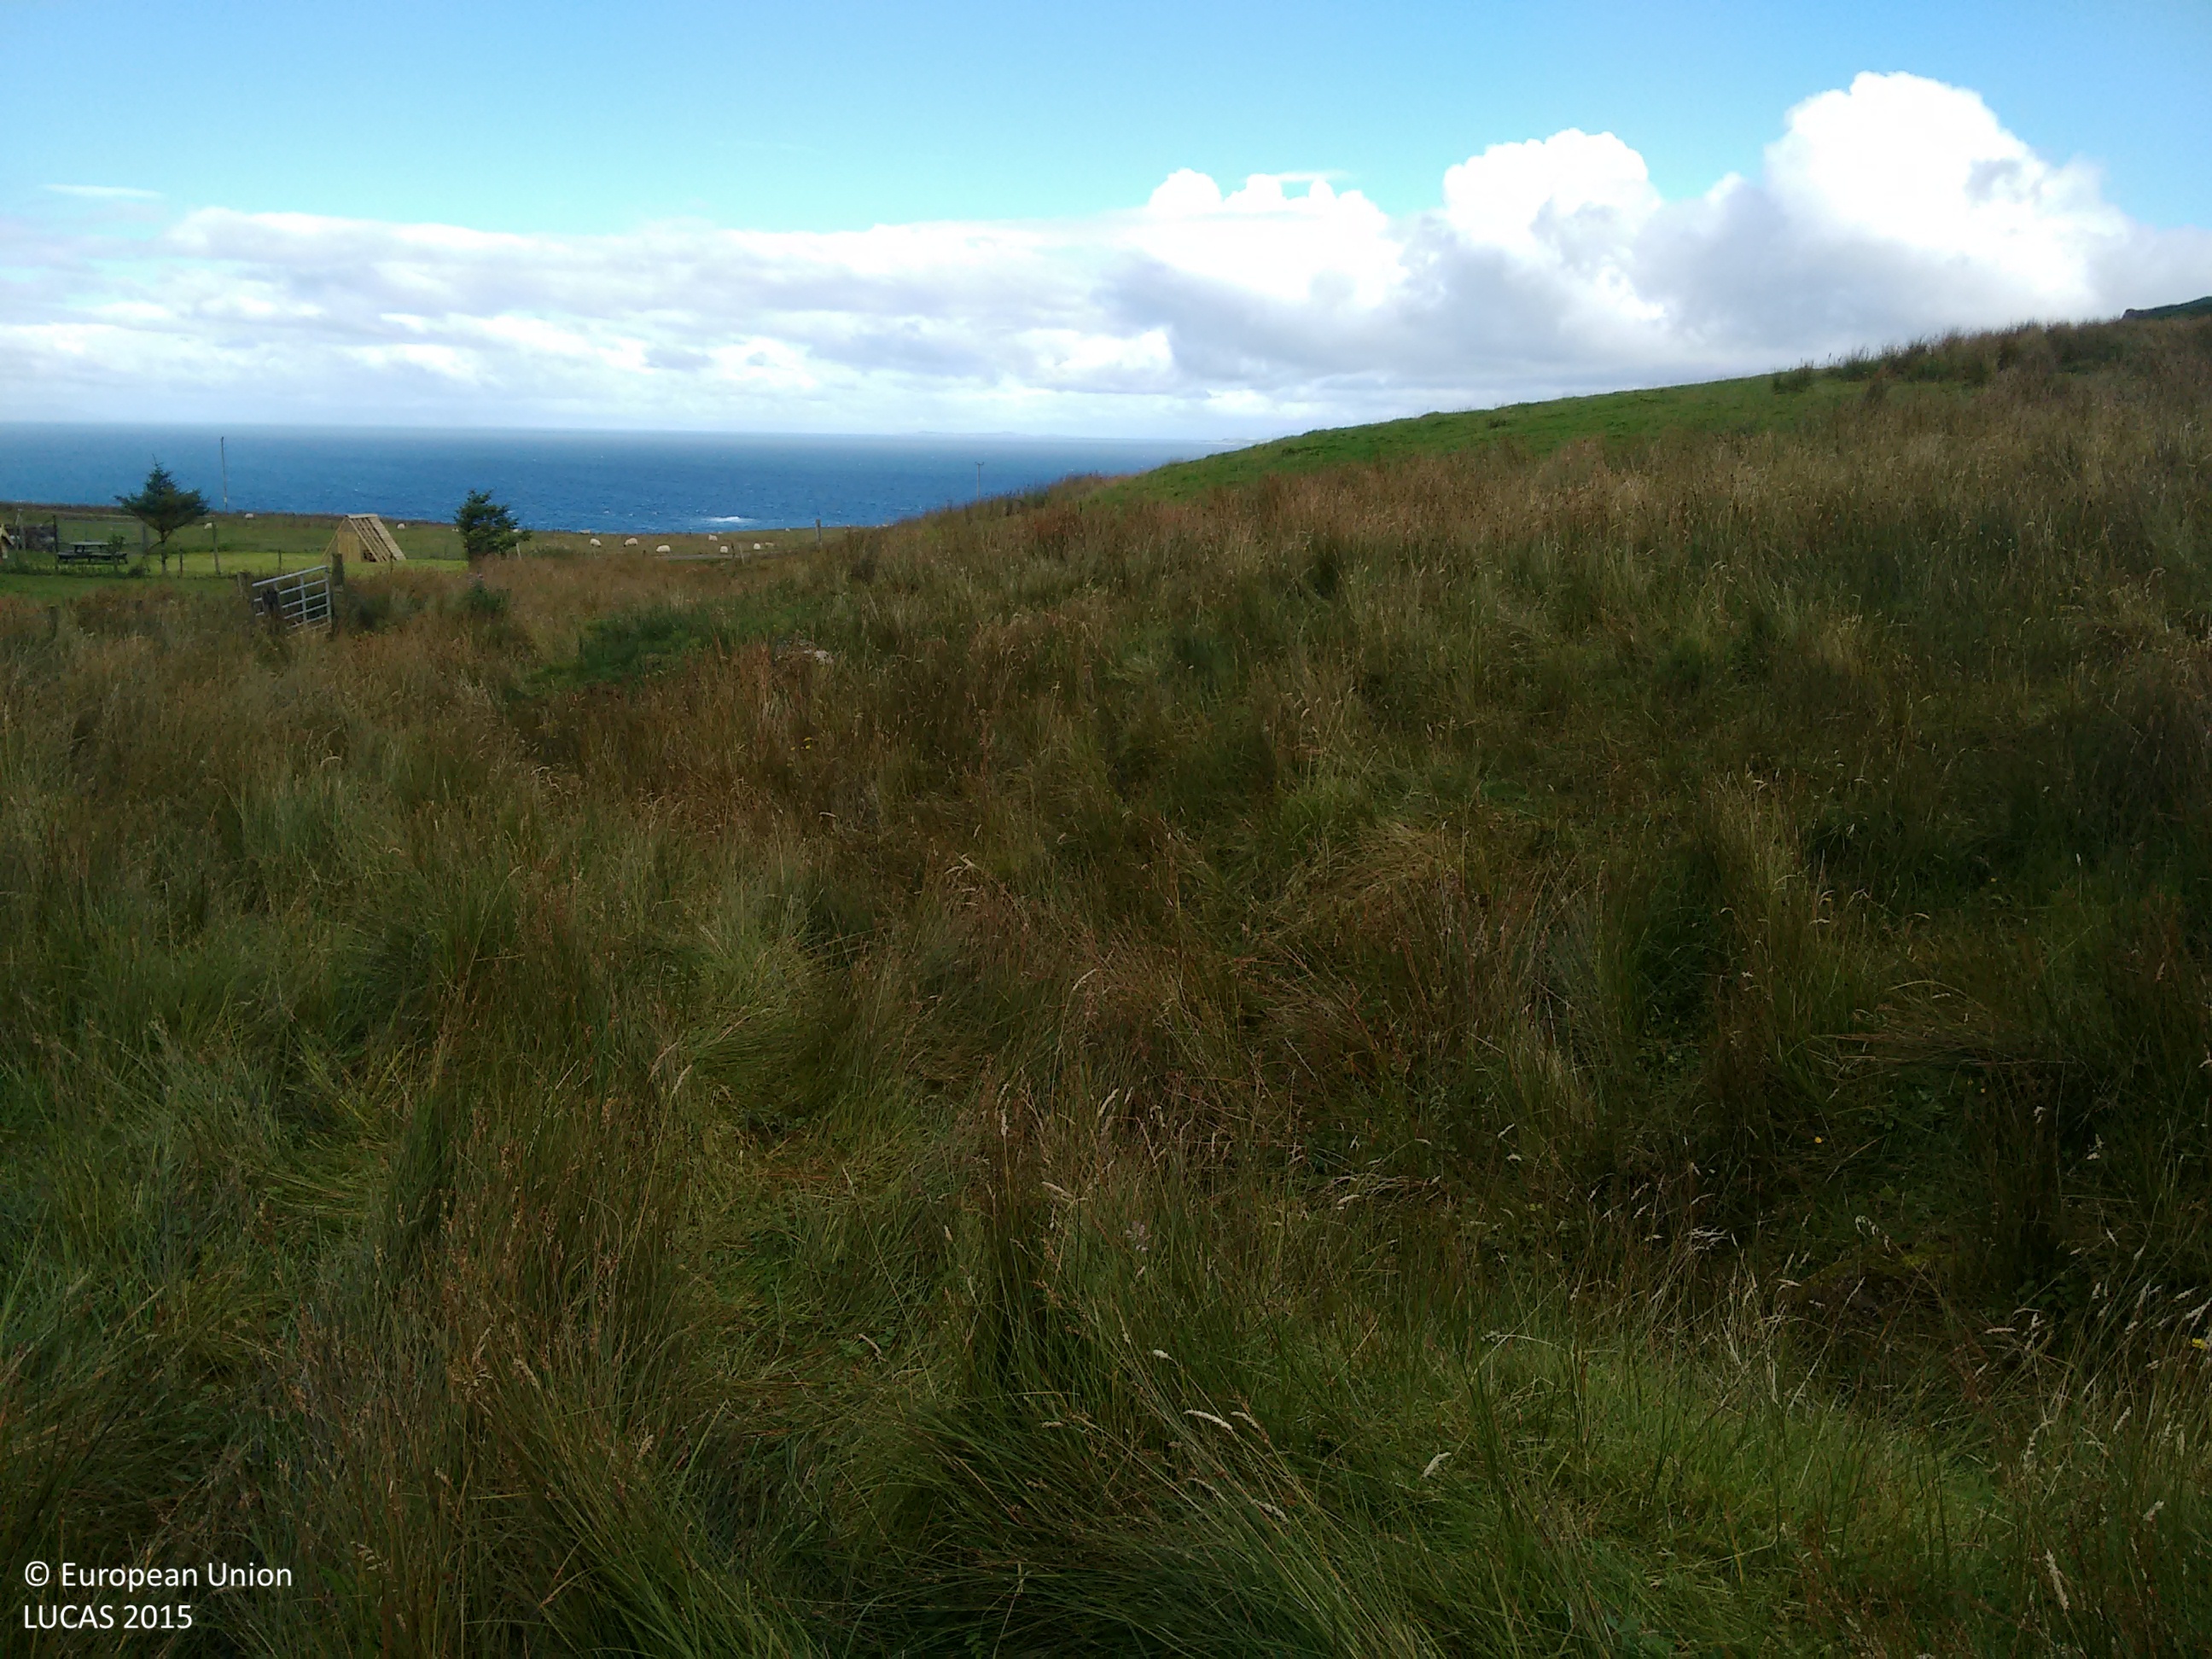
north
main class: Grassland
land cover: Grassland without tree/shrub cover
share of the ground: > 75 %
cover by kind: herbaceous plants 100 %
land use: Agriculture (excluding fallow land and kitchen gardens)
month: September
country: GB
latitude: 55.4077
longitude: -5.7514
